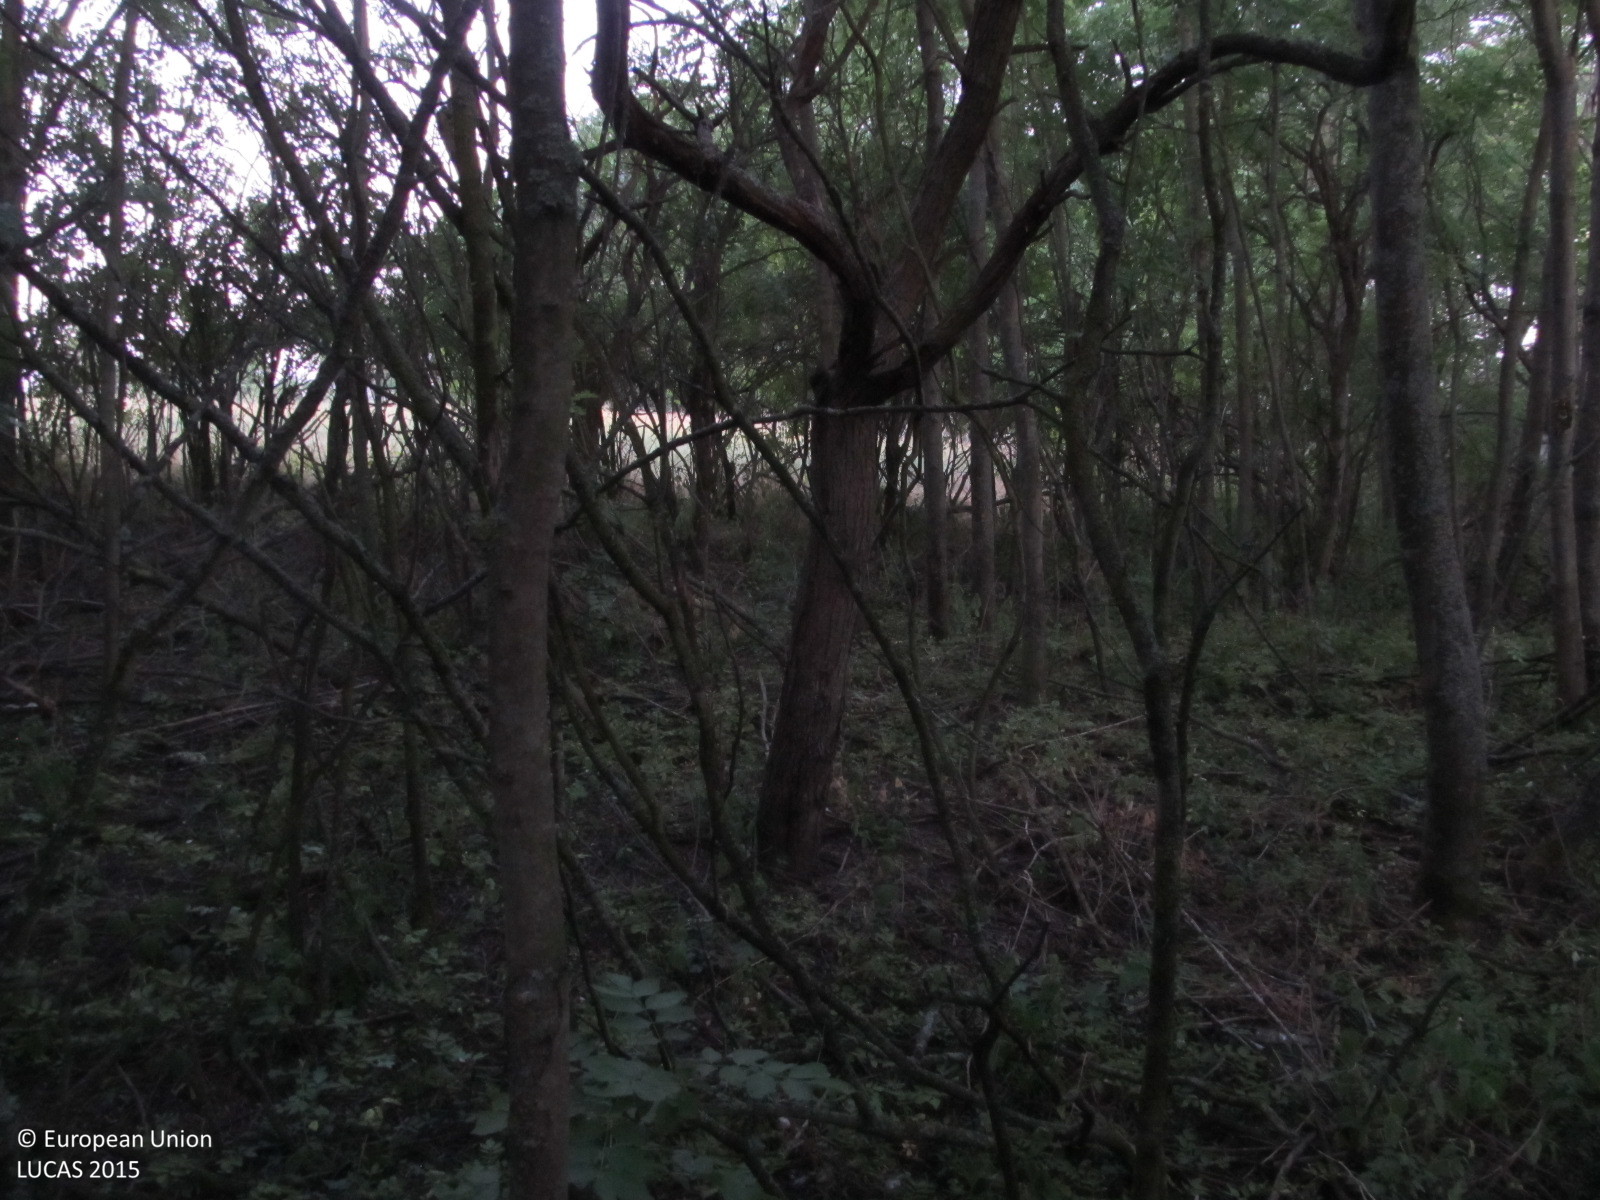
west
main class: Woodland
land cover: Broadleaved woodland
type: mesophytic deciduous forest
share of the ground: > 75 %
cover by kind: broadleaved forest trees 90 %, herbaceous plants 10 %
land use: Forestry
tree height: > 5 m
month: July
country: AT
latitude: 48.6976
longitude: 15.8872
